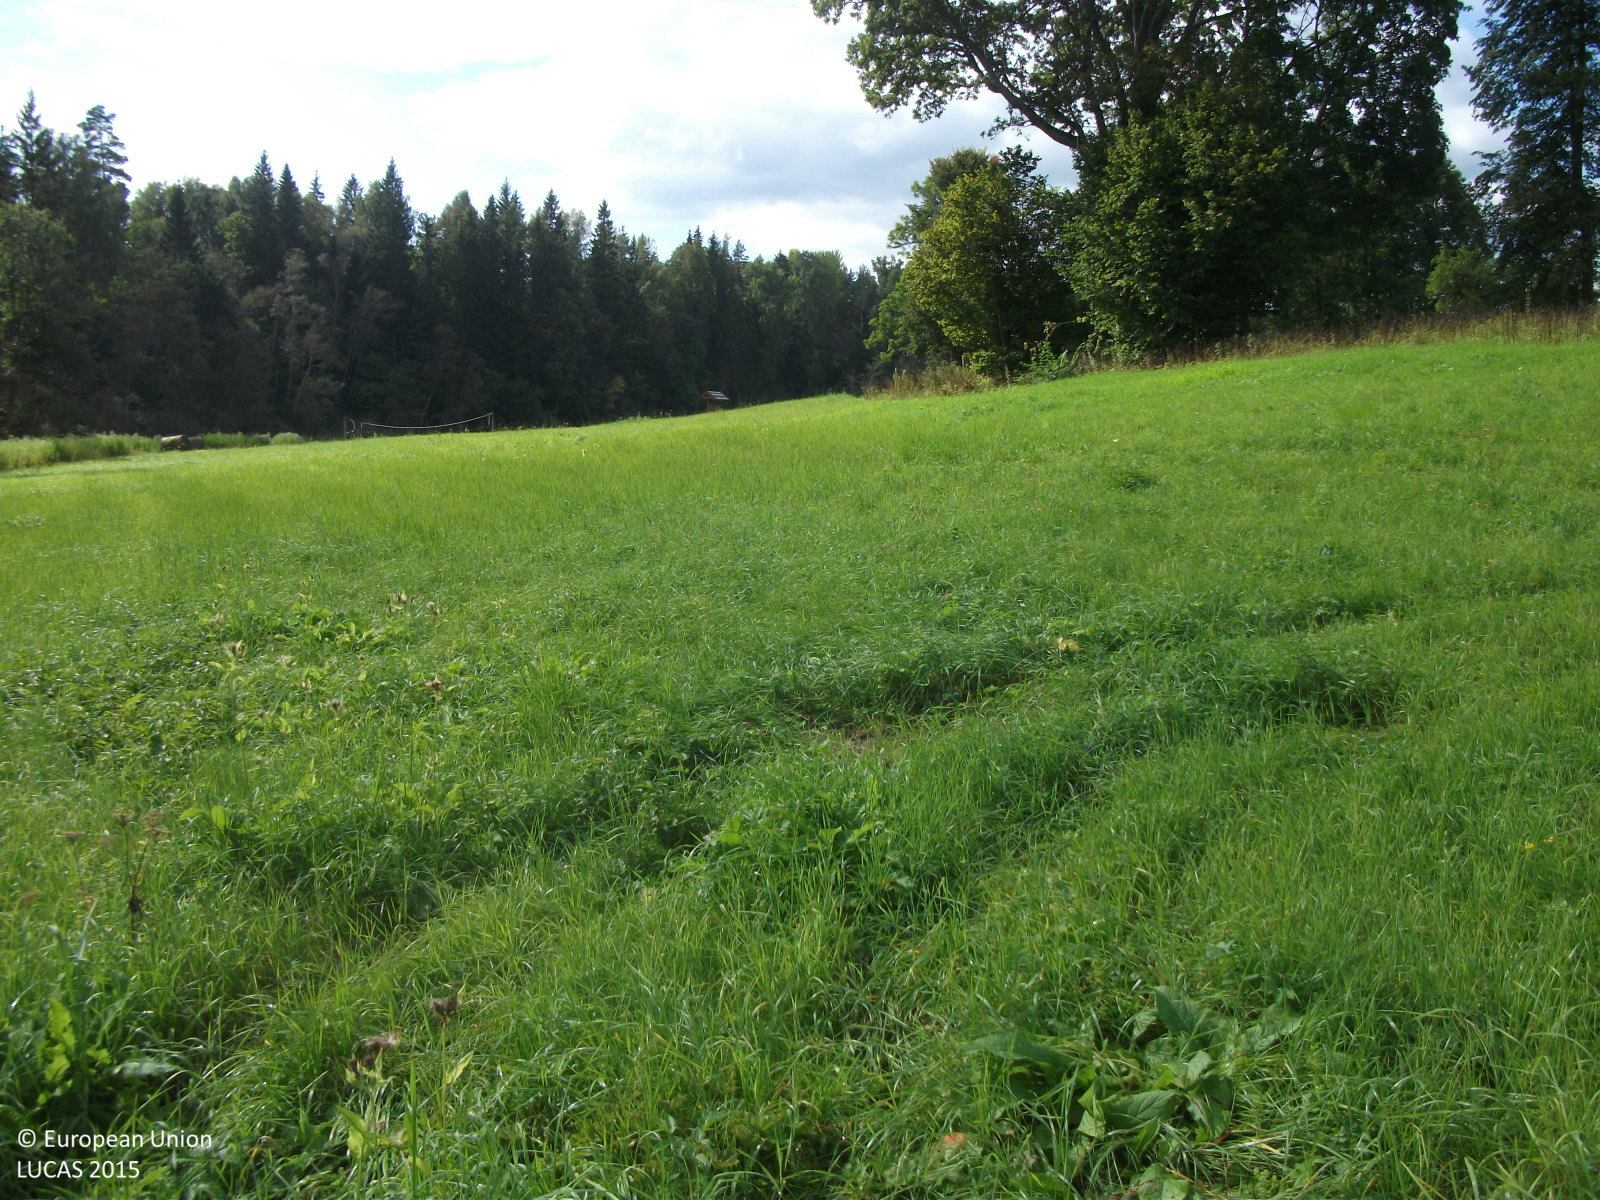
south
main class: Grassland
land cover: Grassland without tree/shrub cover
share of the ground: > 75 %
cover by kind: herbaceous plants 100 %
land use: Agriculture (excluding fallow land and kitchen gardens)
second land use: Amenities, museums, leisure
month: September
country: LV
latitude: 57.9240
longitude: 24.9739
